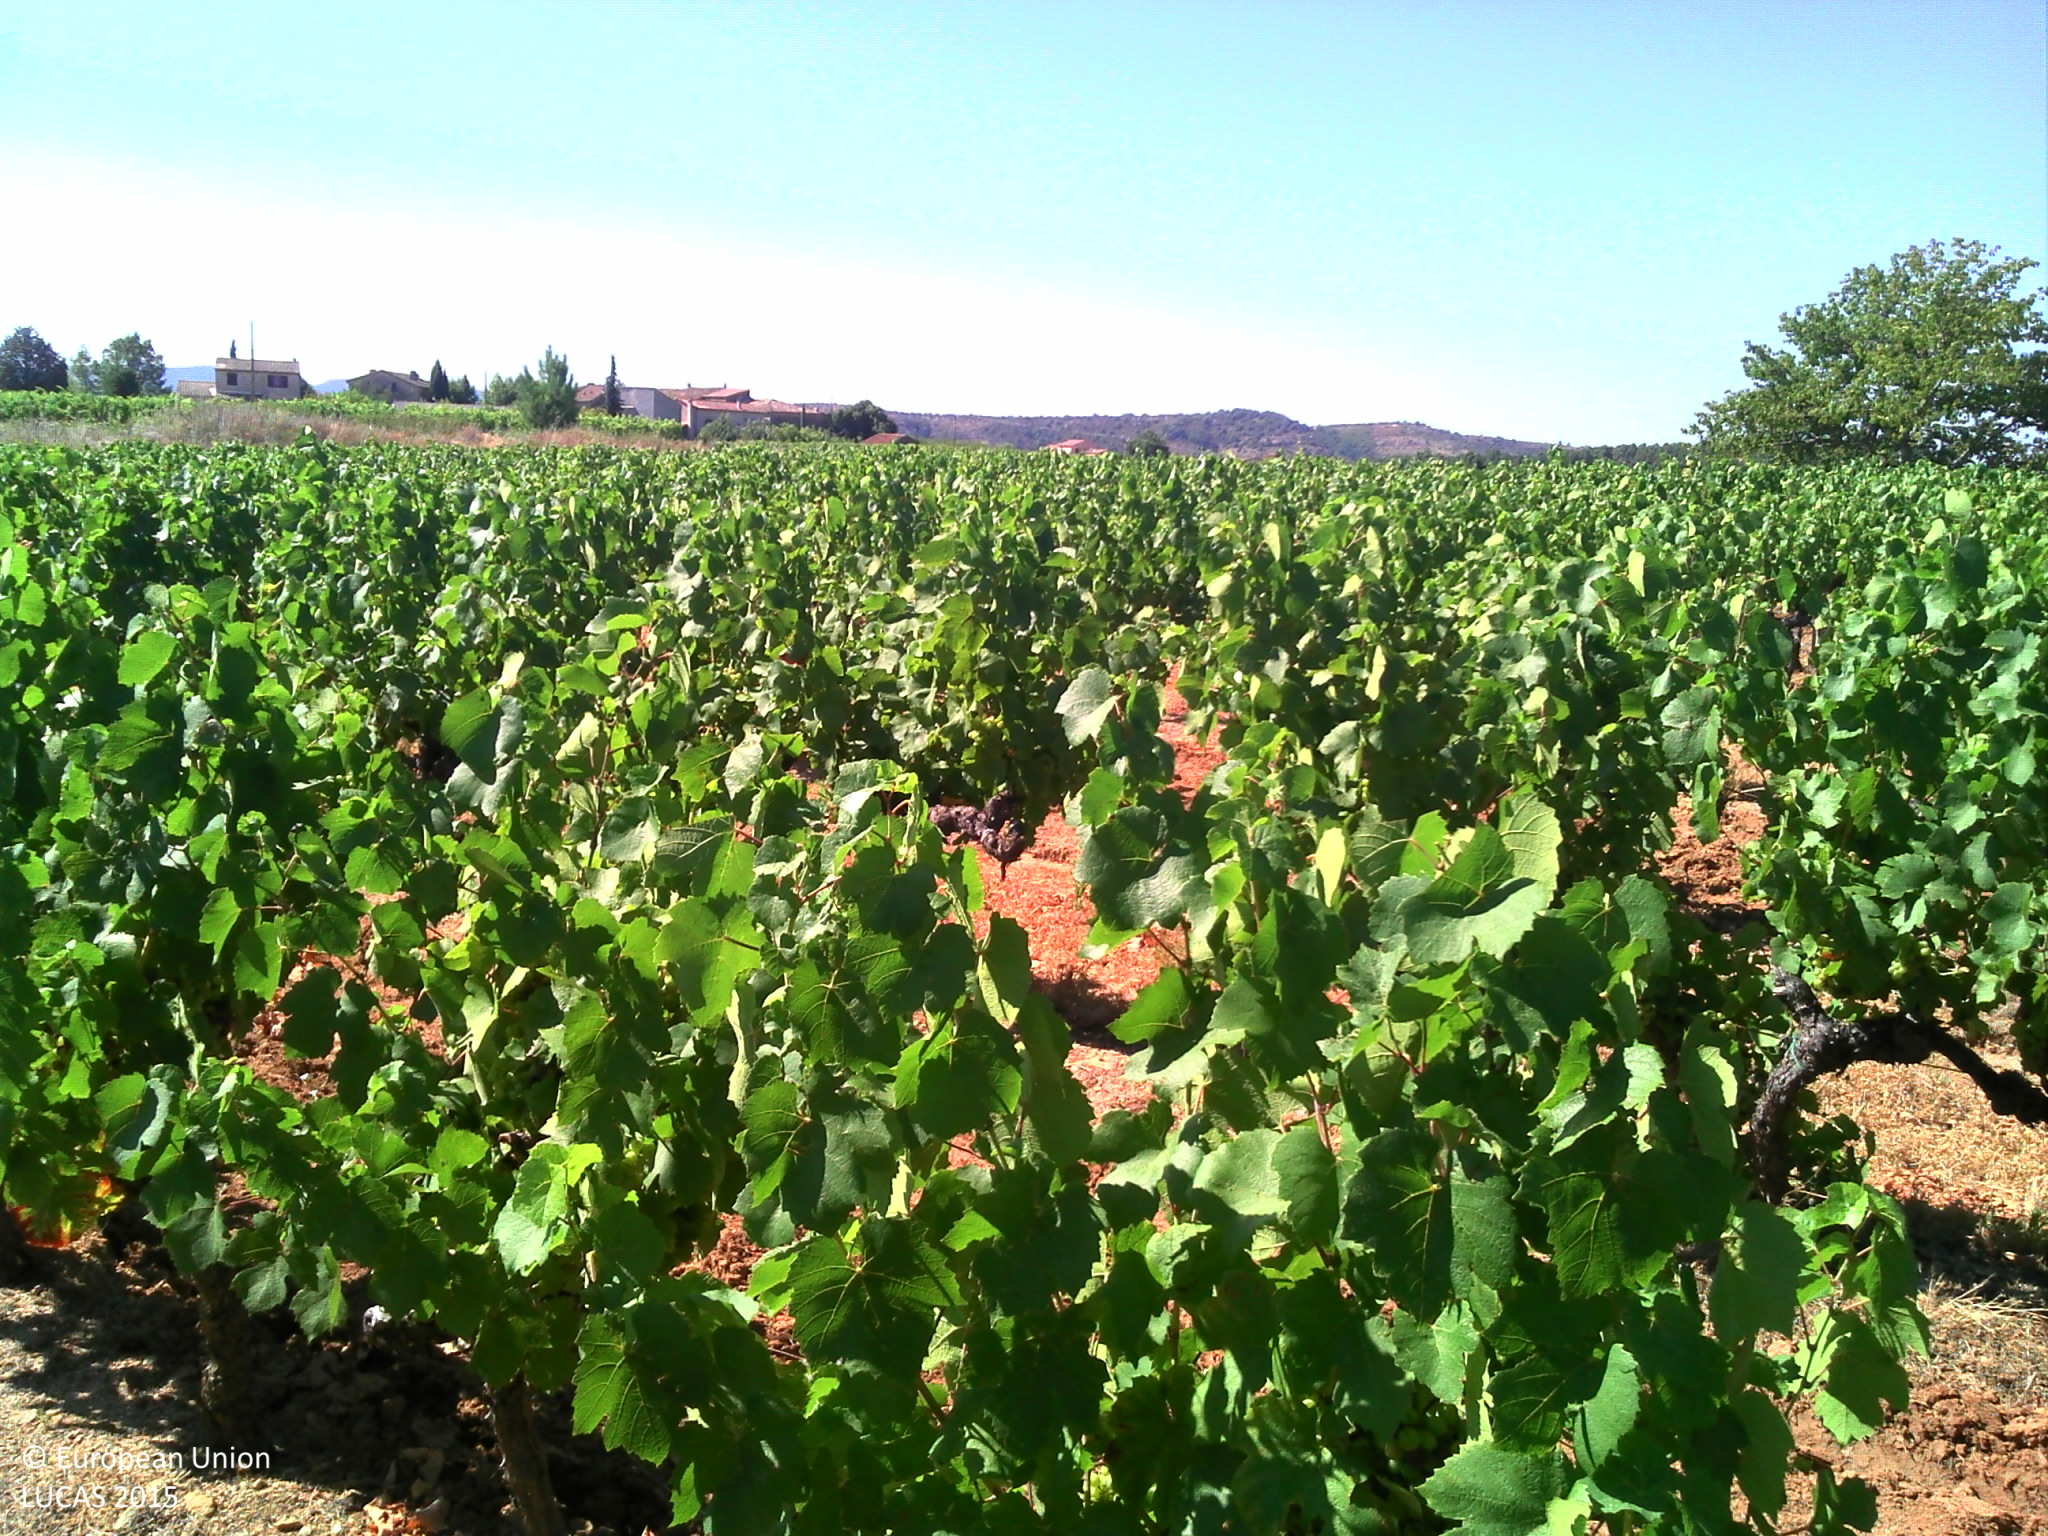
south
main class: Cropland
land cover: Vineyards
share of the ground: 25 - 50 %
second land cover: Other bare soil
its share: > 75 %
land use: Agriculture (excluding fallow land and kitchen gardens)
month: July
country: FR
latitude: 44.4989
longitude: 4.2589
